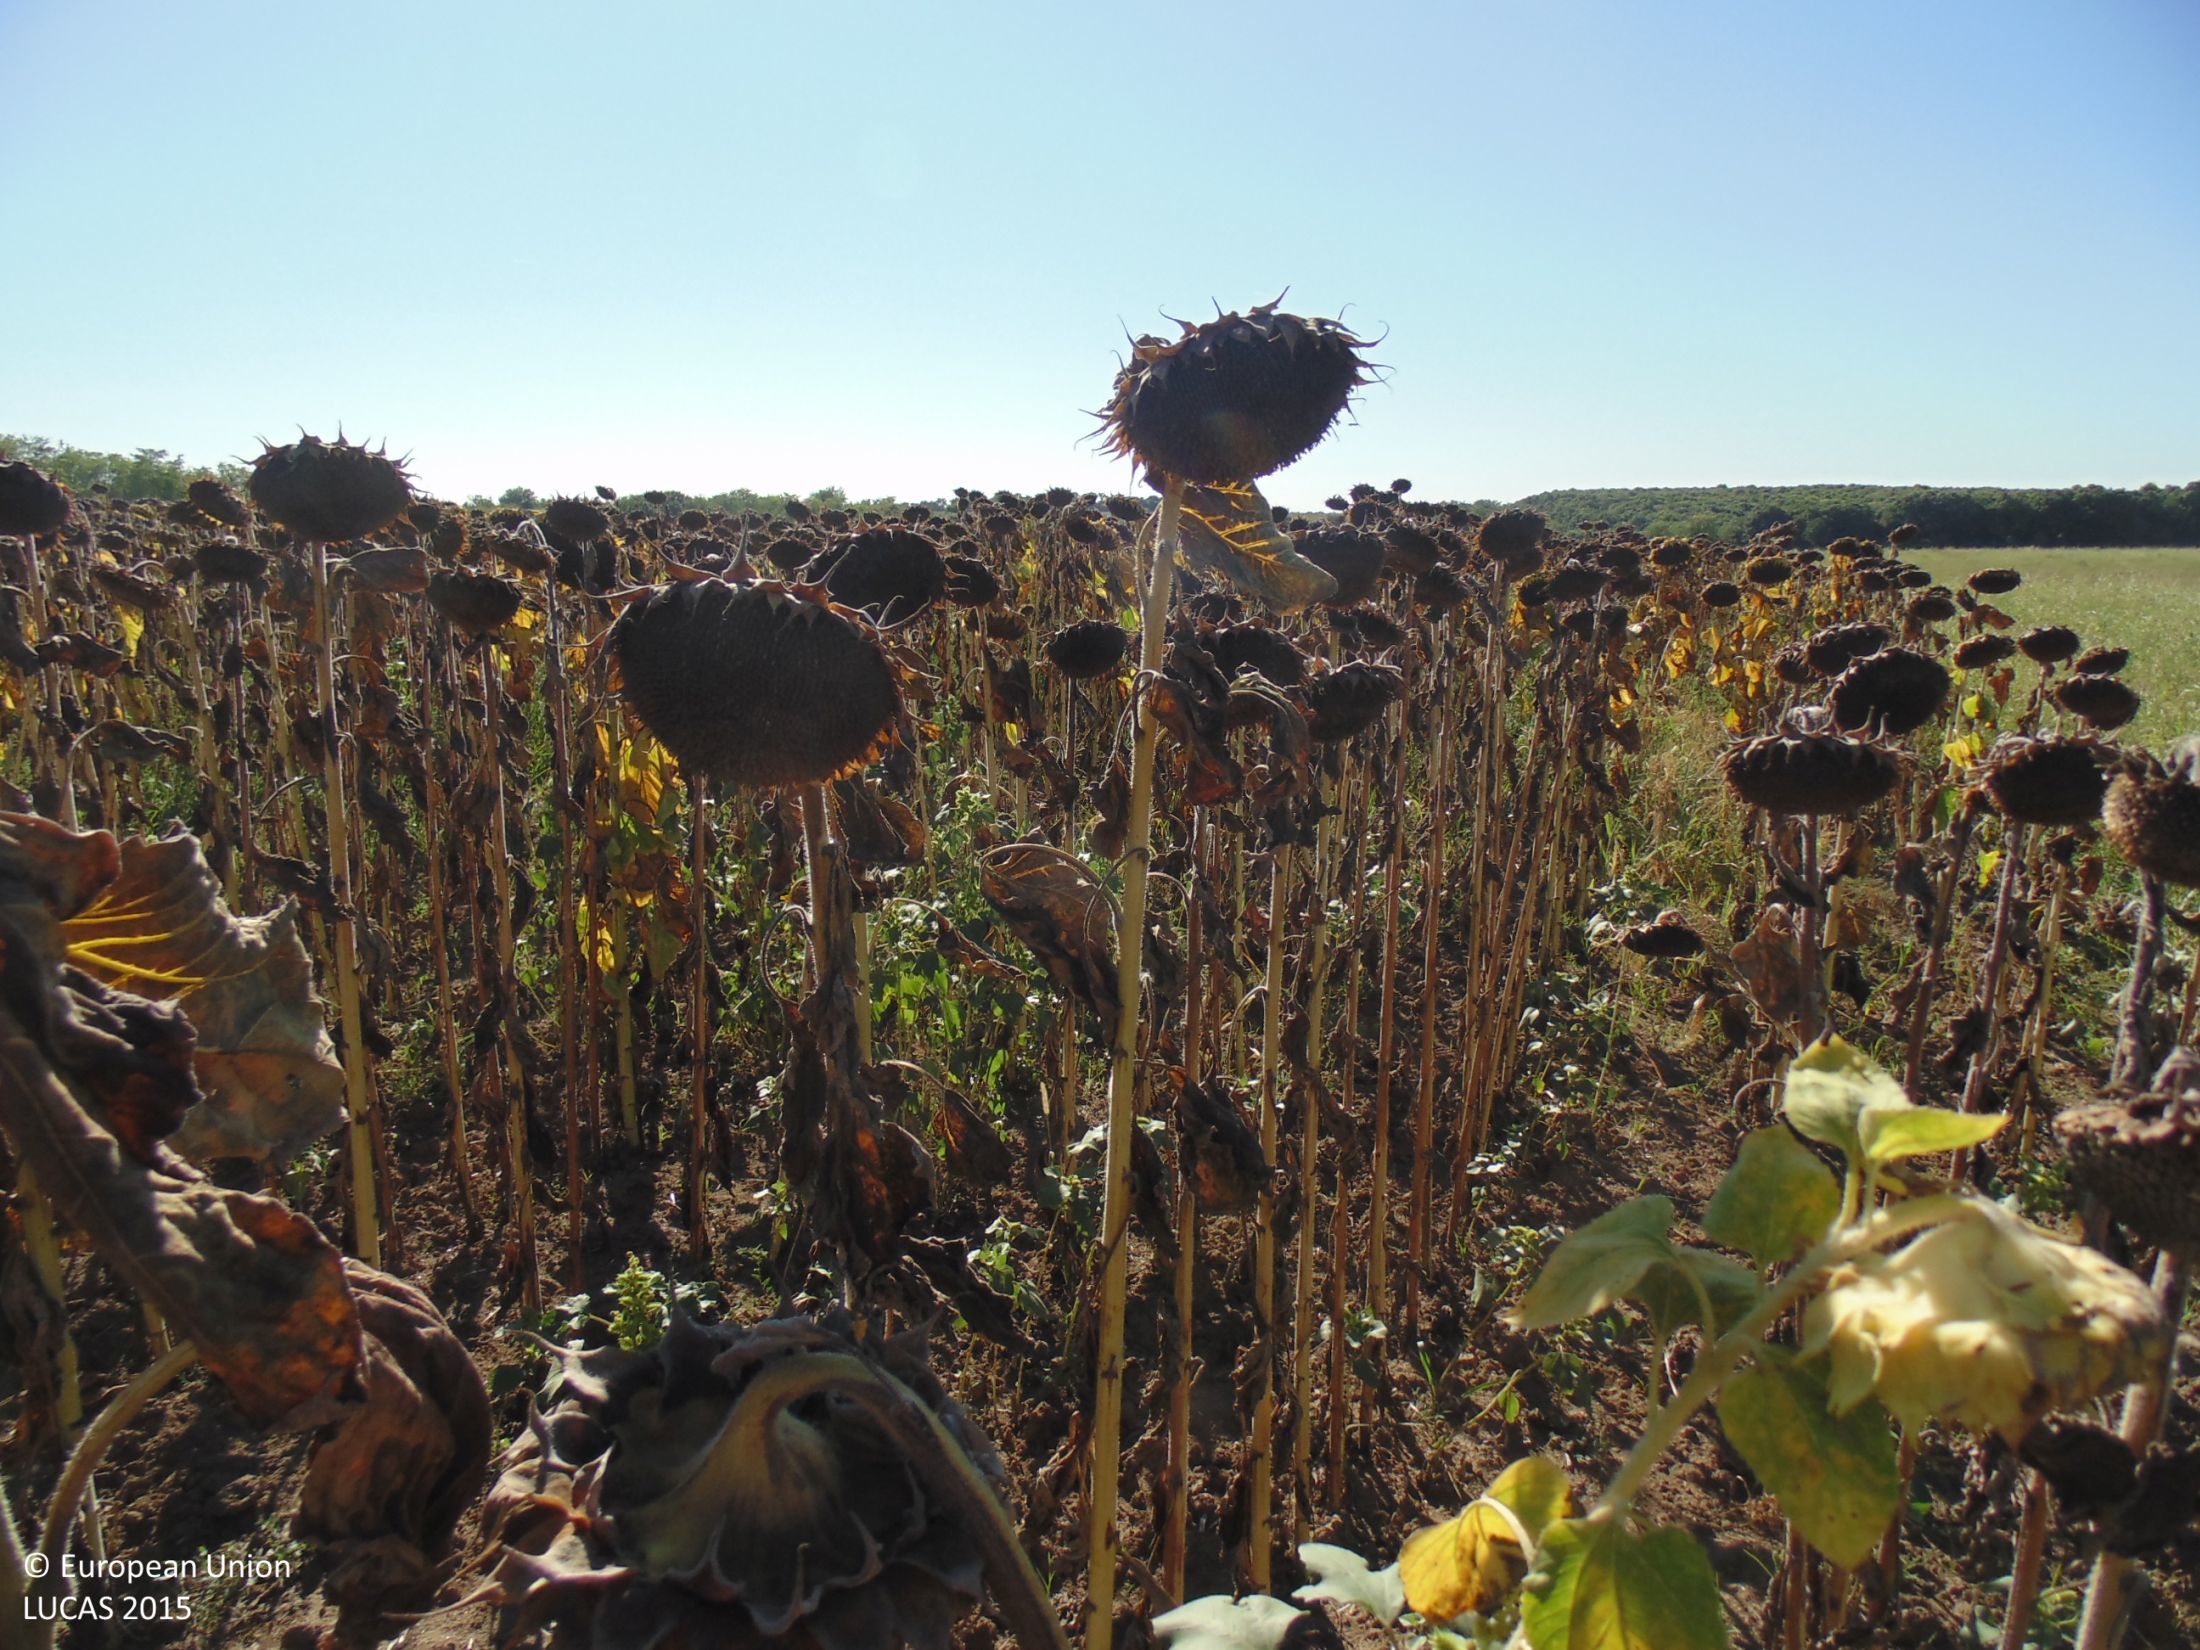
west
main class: Cropland
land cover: Sunflower
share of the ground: > 75 %
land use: Agriculture (excluding fallow land and kitchen gardens)
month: September
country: BG
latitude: 43.8570
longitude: 27.2088
